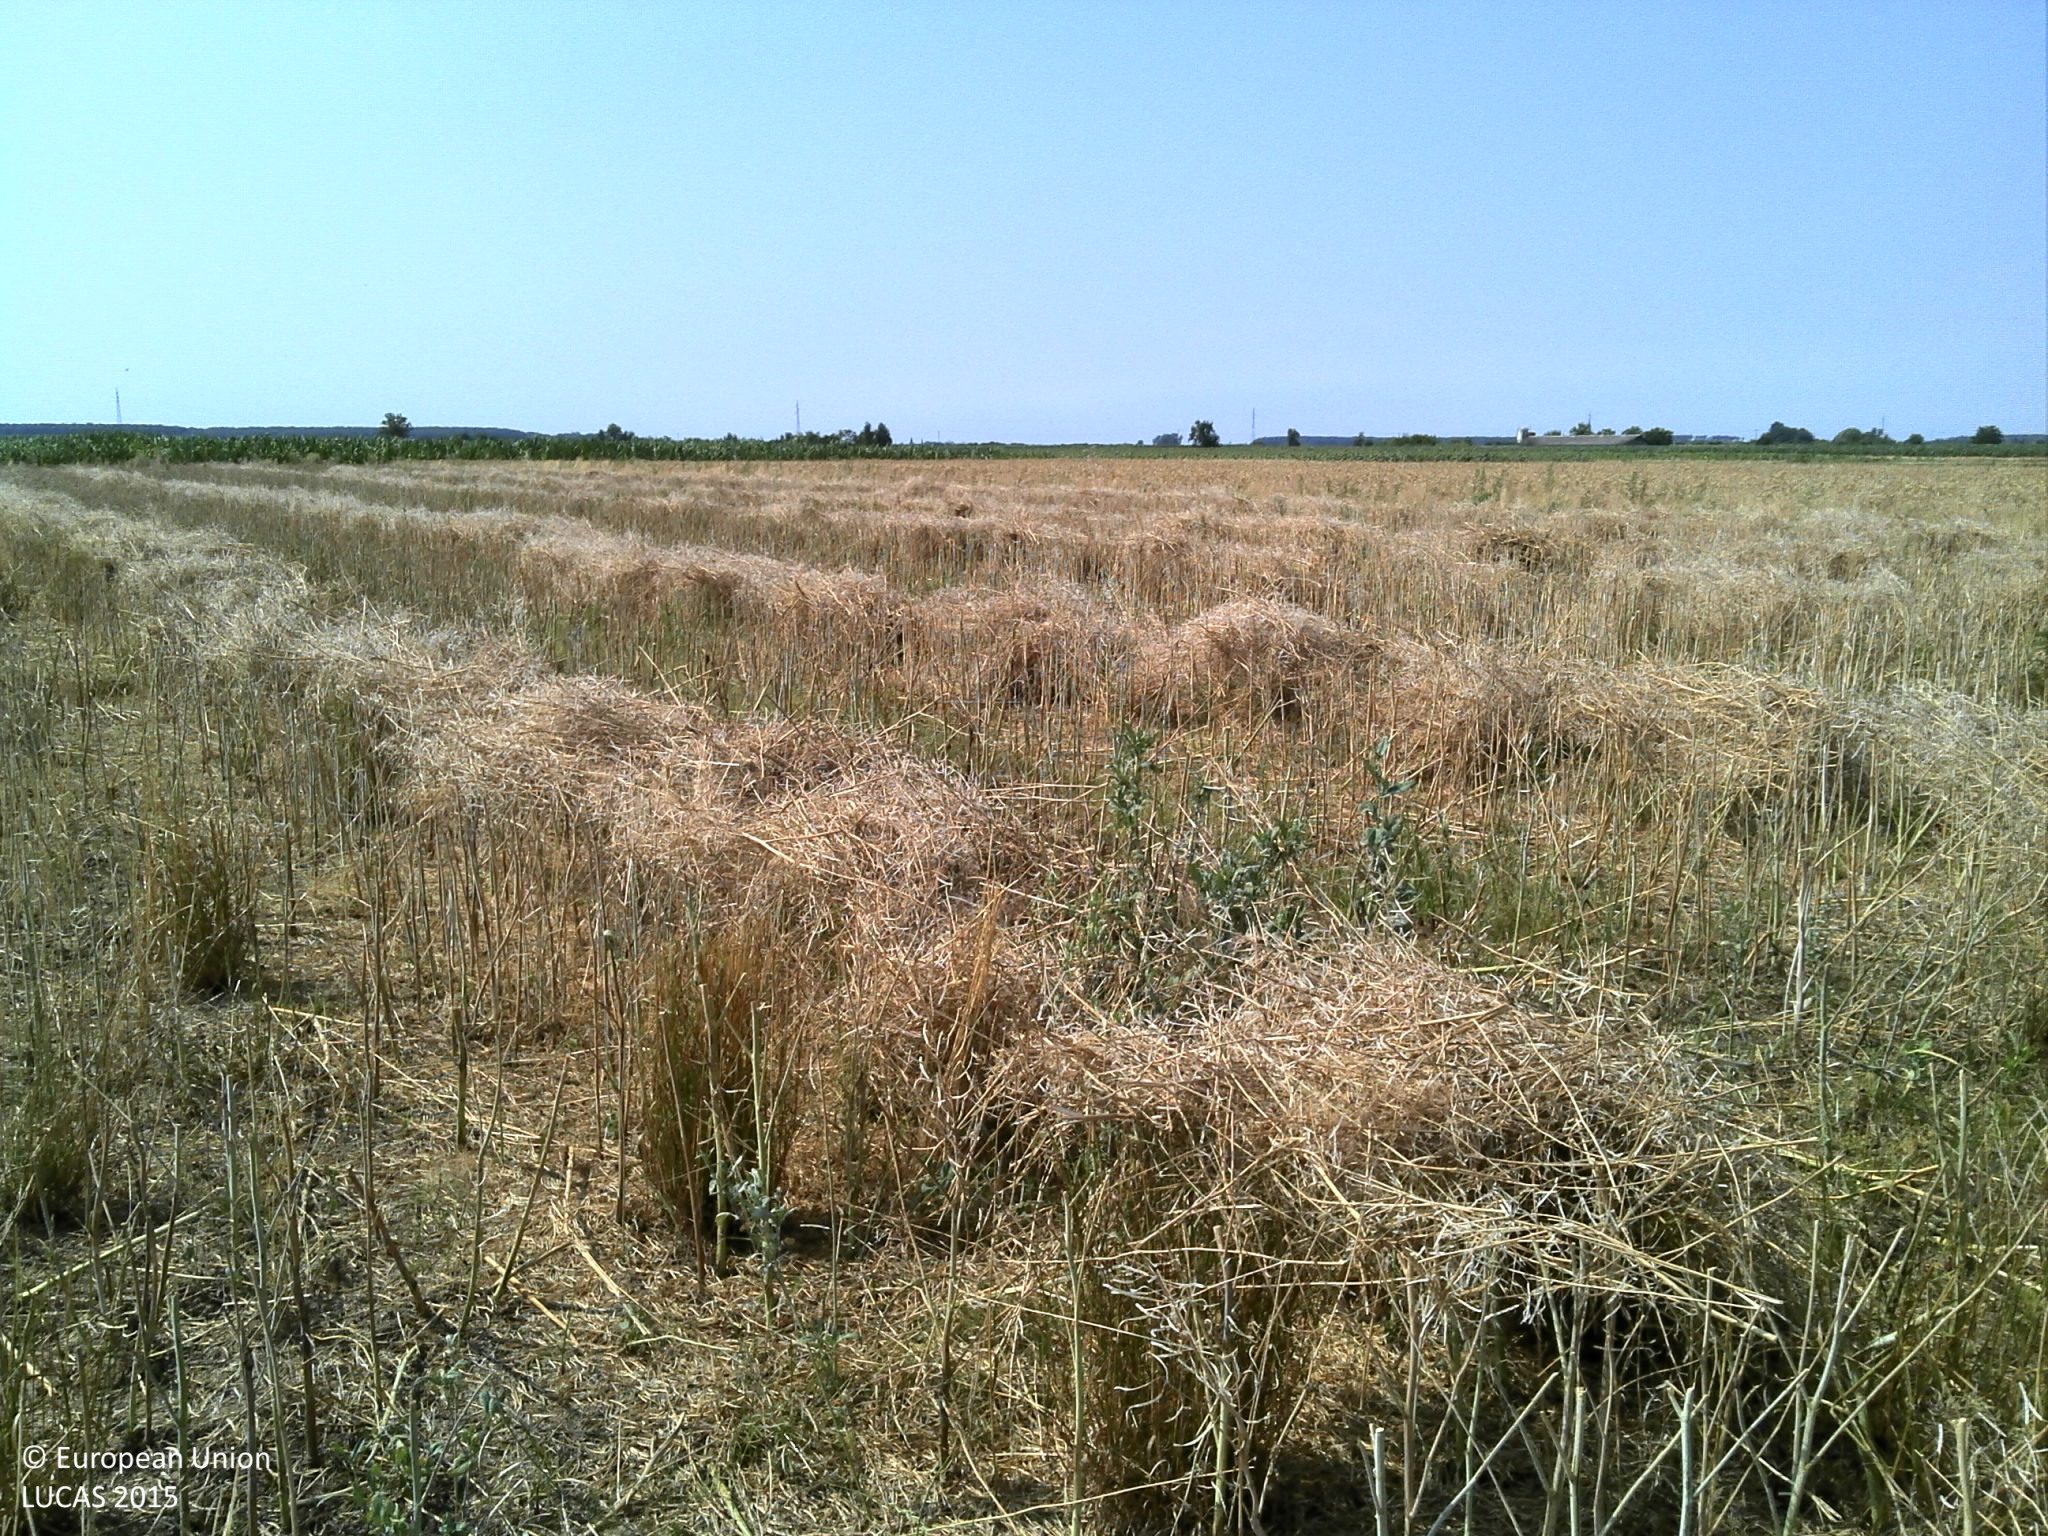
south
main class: Cropland
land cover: Rape and turnip rape
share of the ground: > 75 %
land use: Agriculture (excluding fallow land and kitchen gardens)
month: July
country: HR
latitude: 45.3587
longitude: 18.5206
